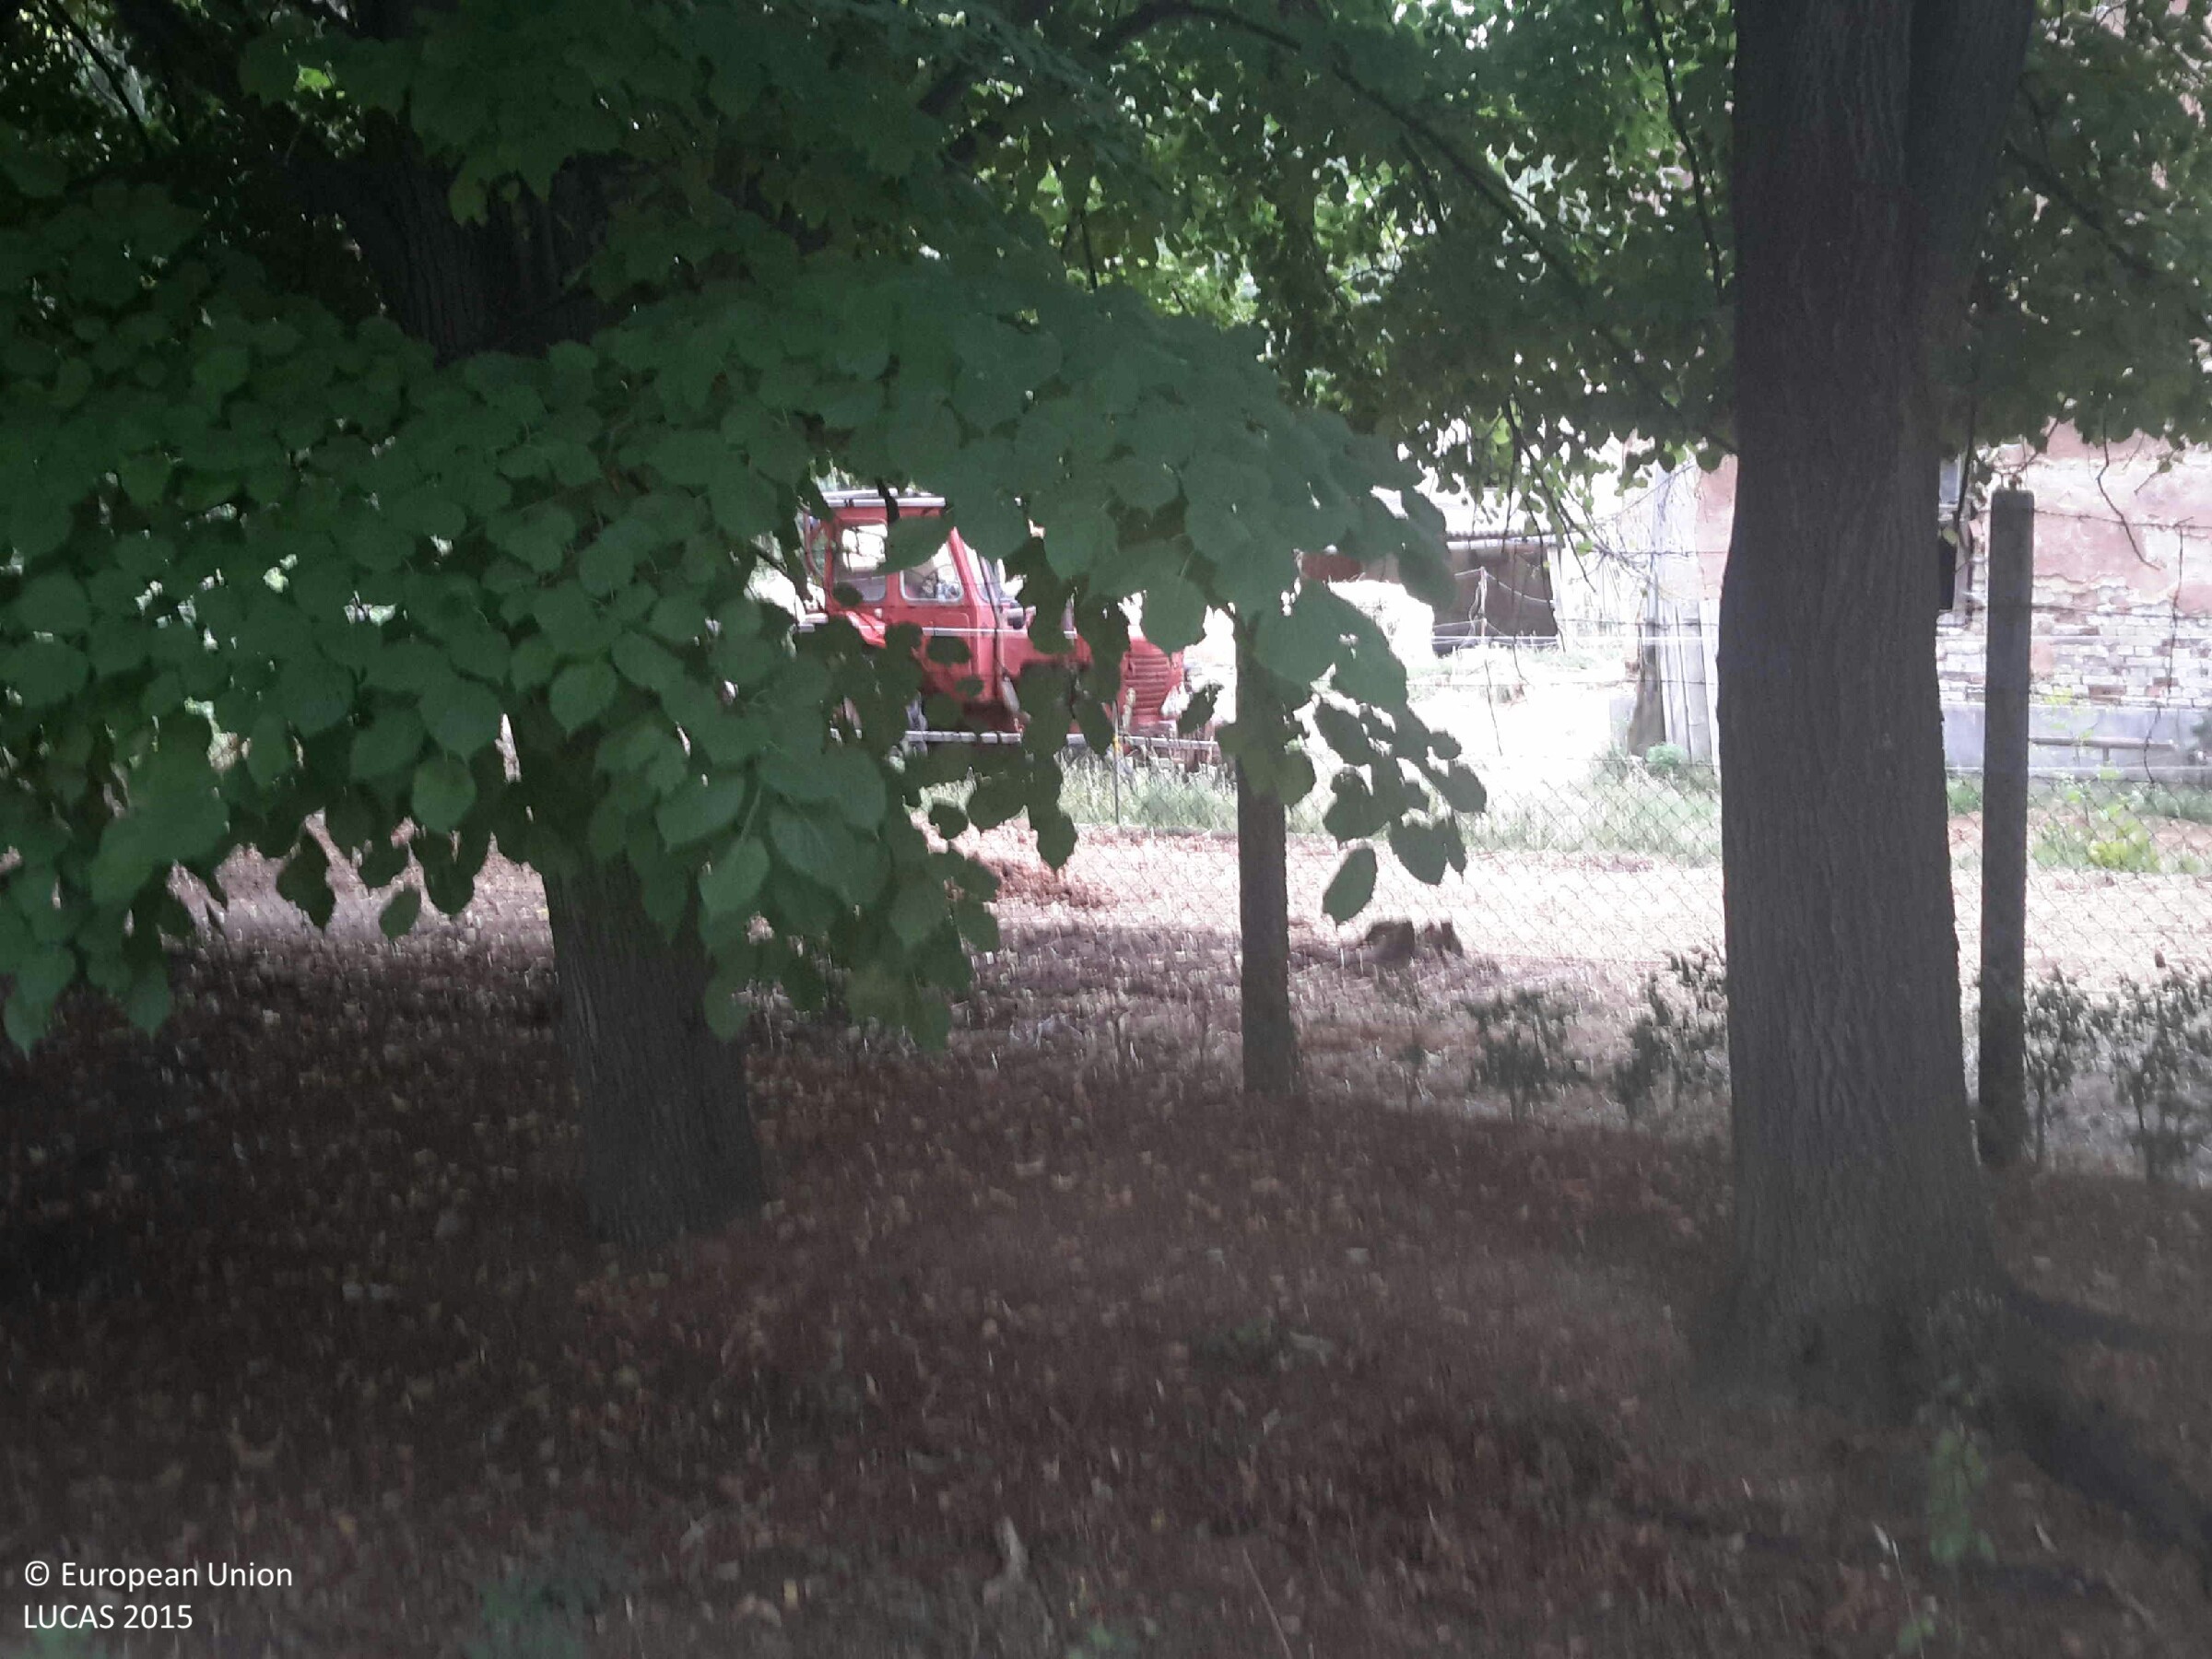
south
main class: Woodland
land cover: Broadleaved woodland
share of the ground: 25 - 50 %
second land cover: Grassland without tree/shrub cover
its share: 50 - 75 %
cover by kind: herbaceous plants 60 %, broadleaved forest trees 40 %
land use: Agriculture (excluding fallow land and kitchen gardens)
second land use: Amenities, museums, leisure
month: July
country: HU
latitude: 47.5688
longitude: 16.6908
